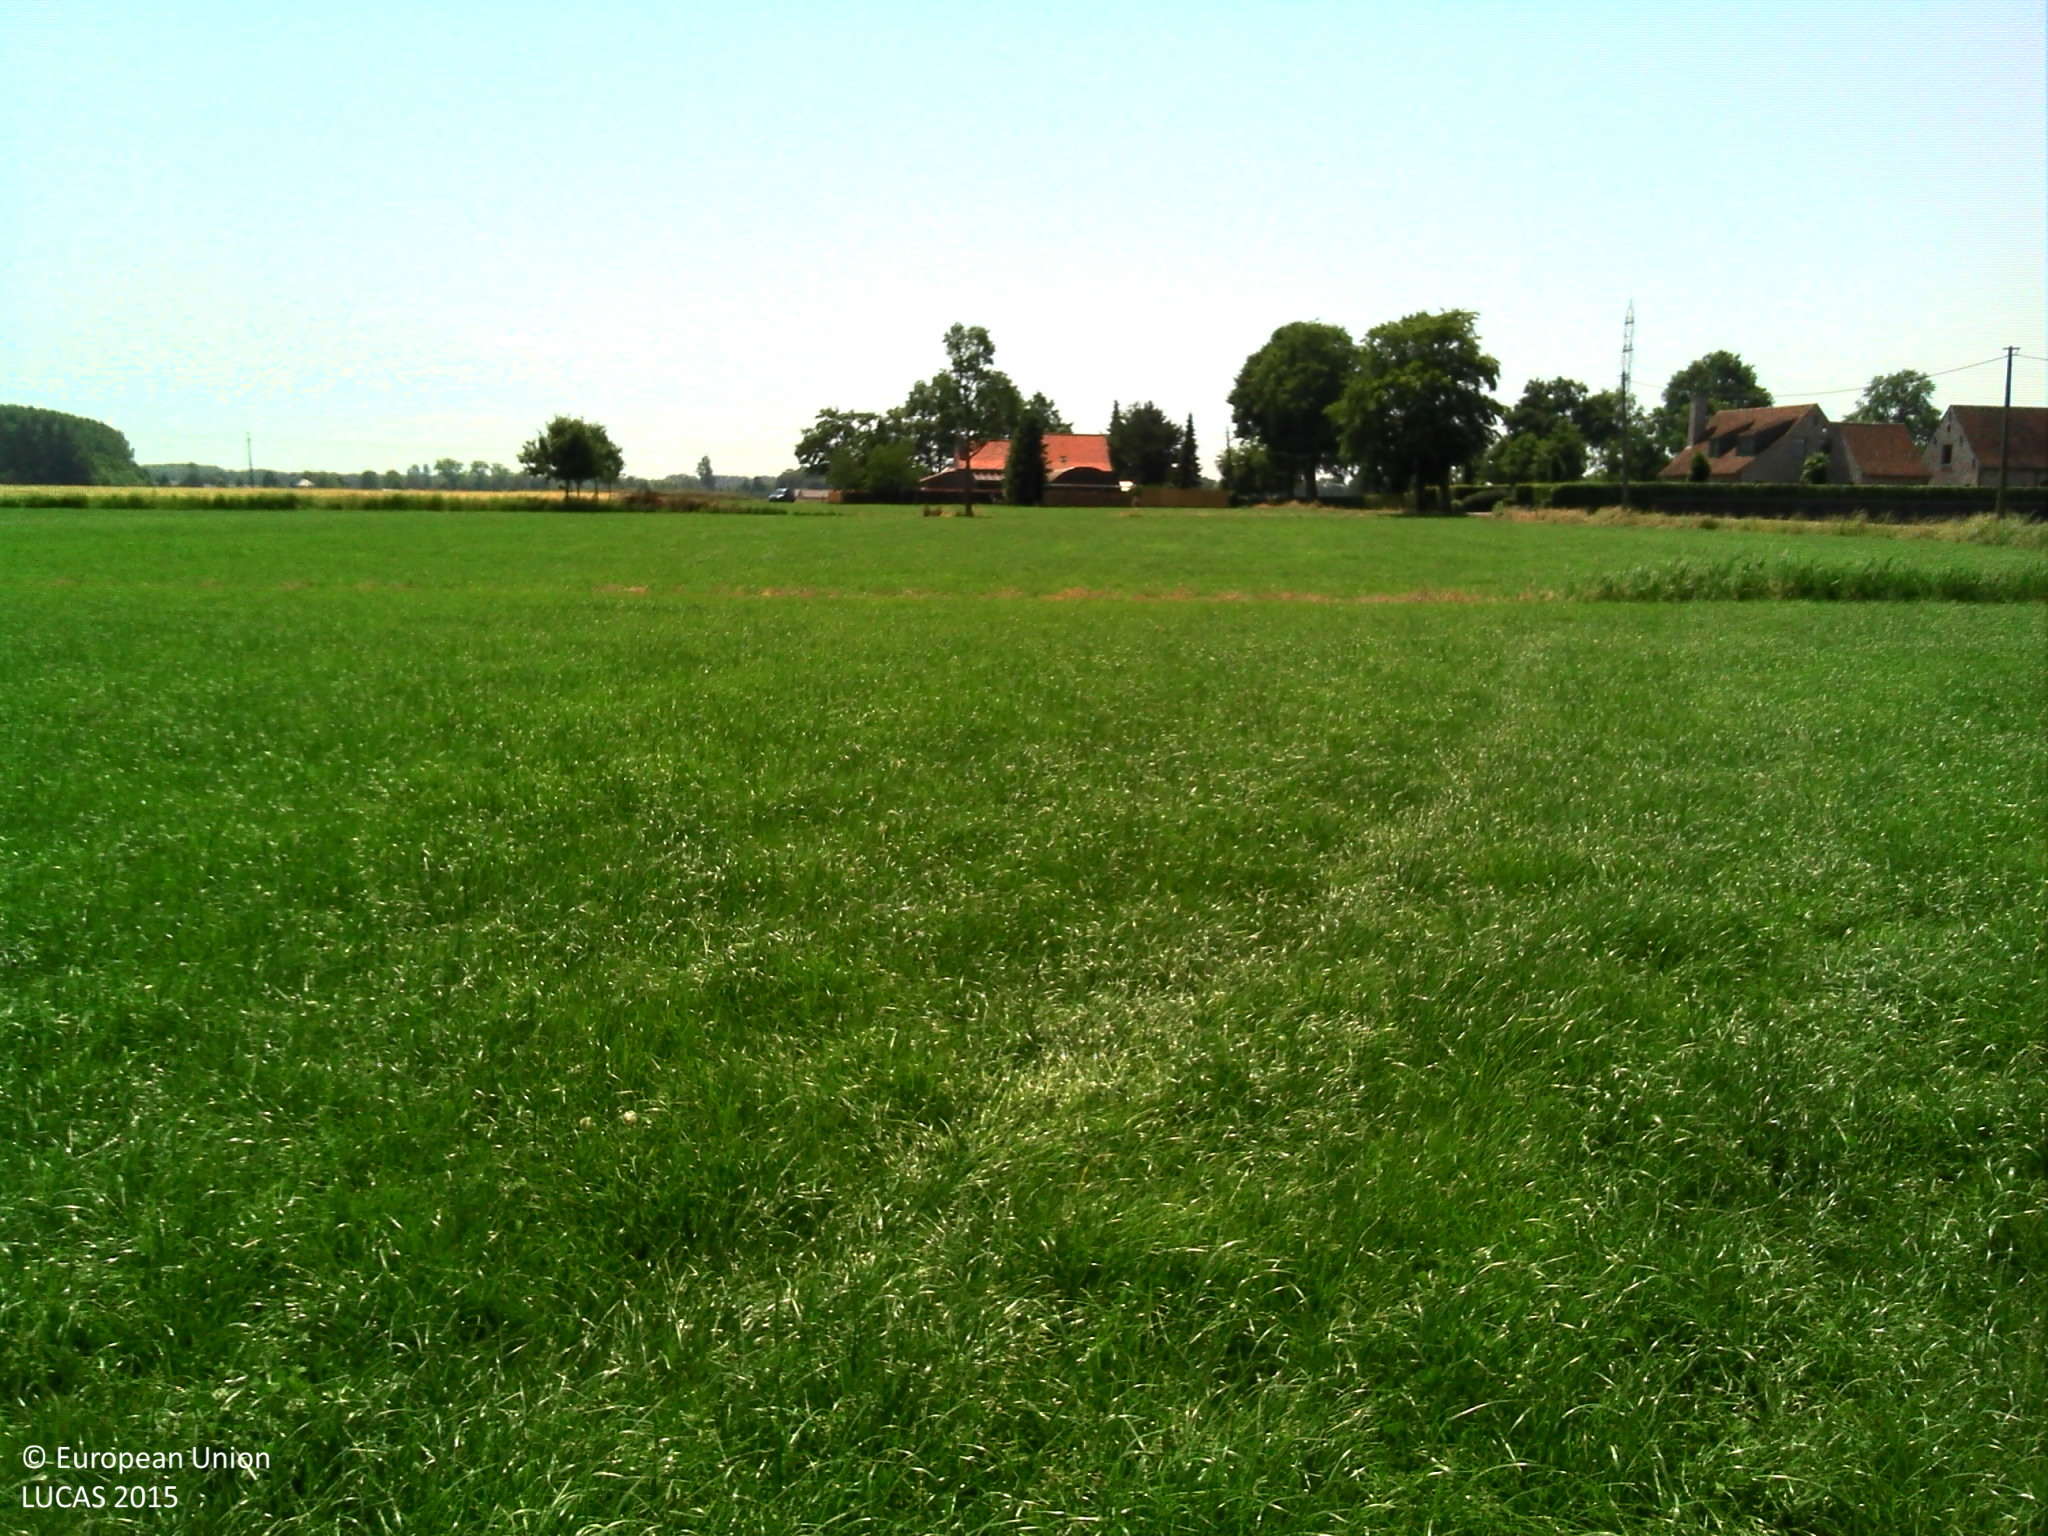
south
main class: Cropland
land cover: Temporary grasslands
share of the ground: > 75 %
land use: Agriculture (excluding fallow land and kitchen gardens)
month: July
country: BE
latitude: 51.2014
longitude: 3.3939
